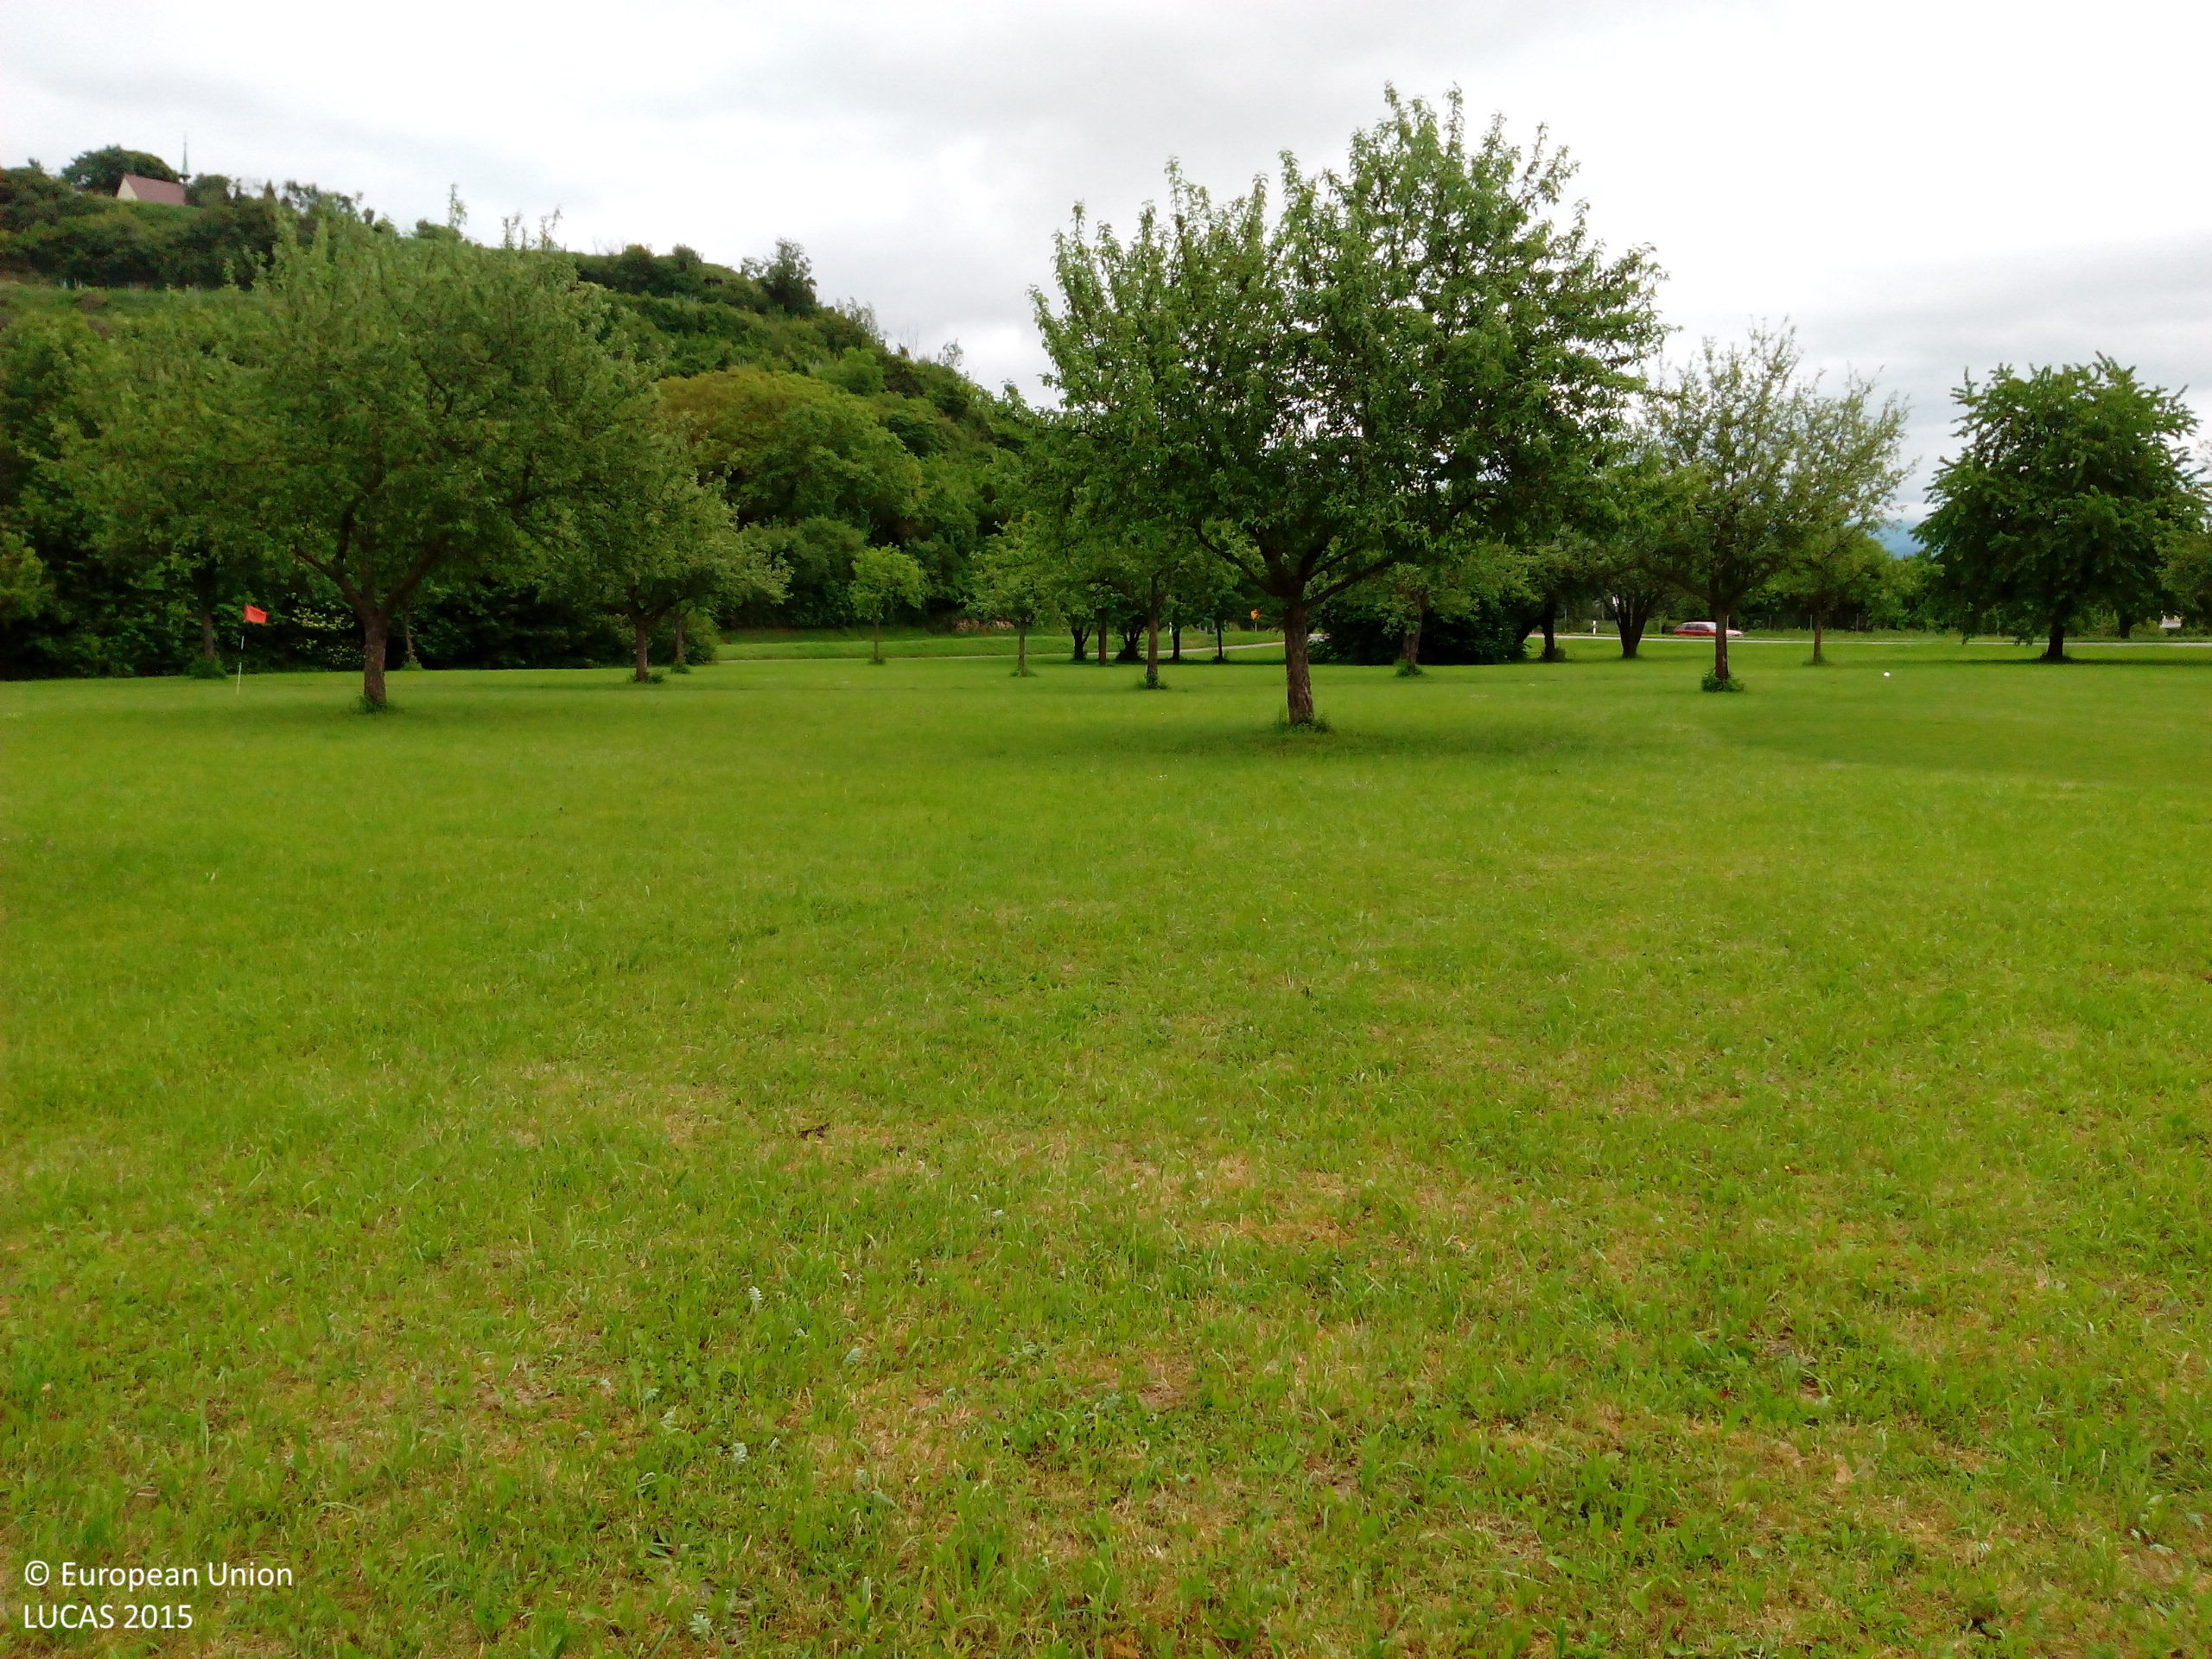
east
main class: Grassland
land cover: Grassland without tree/shrub cover
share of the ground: > 75 %
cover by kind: herbaceous plants 100 %
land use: Sport
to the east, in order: Grassland without tree/shrub cover; Apple fruit; Cherry fruit; Grassland without tree/shrub cover; Paved roads, cycling and walking lanes; Grass margins; Paved roads, cycling and walking lanes; Grass margins; Broadleaved woodland; Apple fruit; Fences; Grass margins; Tracks; Grass margins; Broadleaved woodland
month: May
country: DE
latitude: 47.9652
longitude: 7.6841
